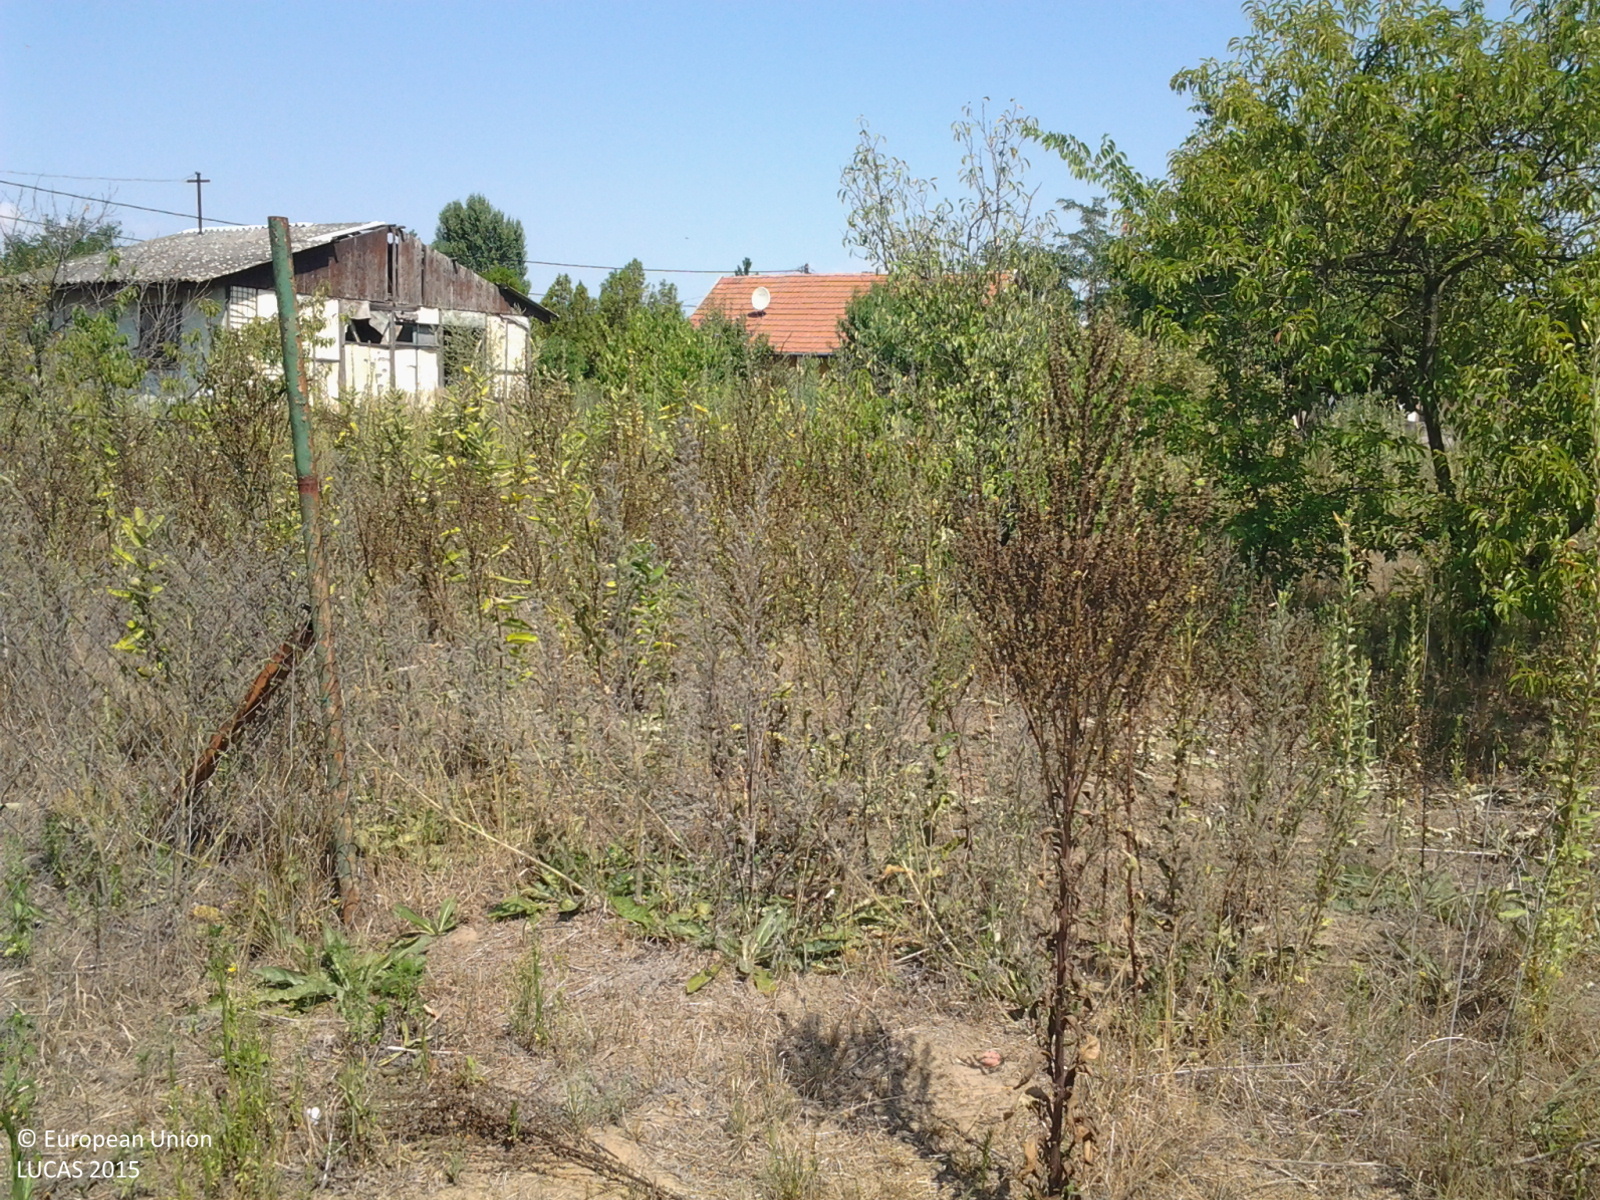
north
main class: Grassland
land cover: Spontaneously vegetated surfaces
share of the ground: > 75 %
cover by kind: herbaceous plants 100 %
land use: Fallow land
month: August
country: HU
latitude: 47.3349
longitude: 19.7766
